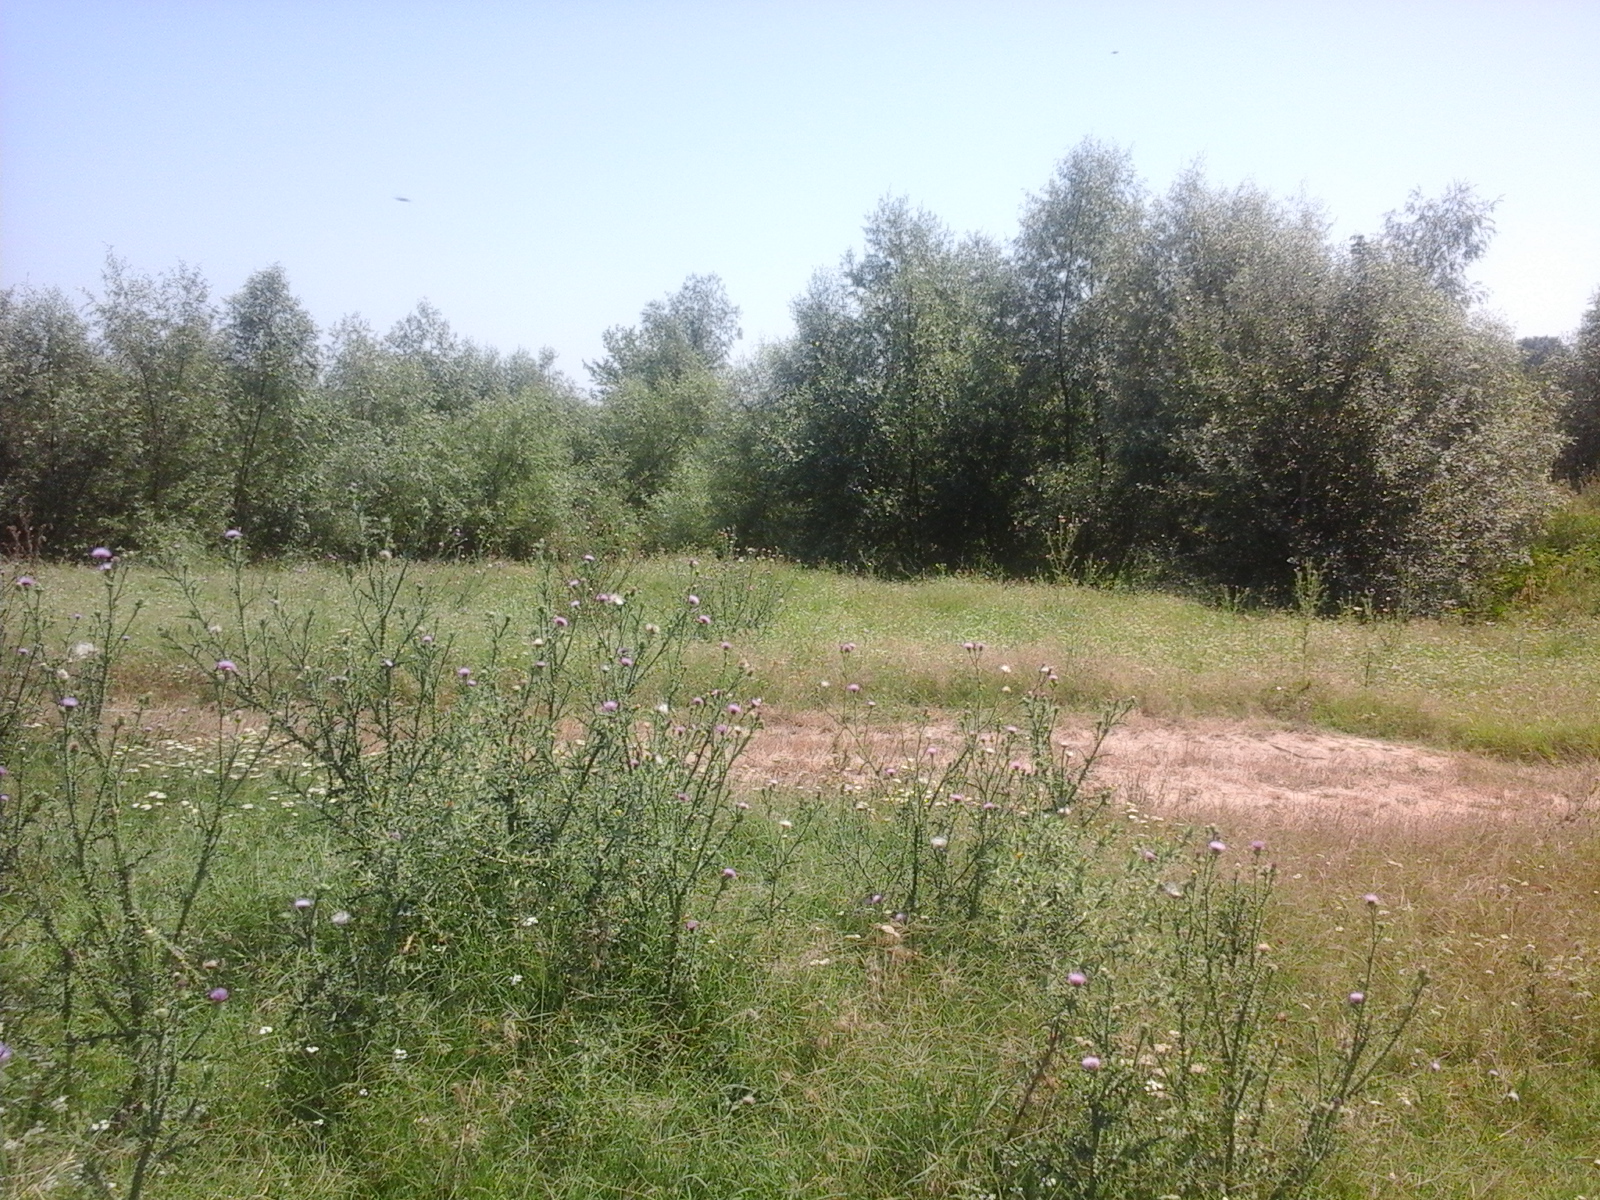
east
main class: Grassland
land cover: Spontaneously vegetated surfaces
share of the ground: > 75 %
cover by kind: herbaceous plants 100 %
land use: Fallow land
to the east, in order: Spontaneously vegetated surfaces; Tracks; Spontaneously vegetated surfaces; Broadleaved woodland; Spontaneously vegetated surfaces; Tracks; Grass margins; Maize
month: July
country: RO
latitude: 44.5507
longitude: 27.2431
